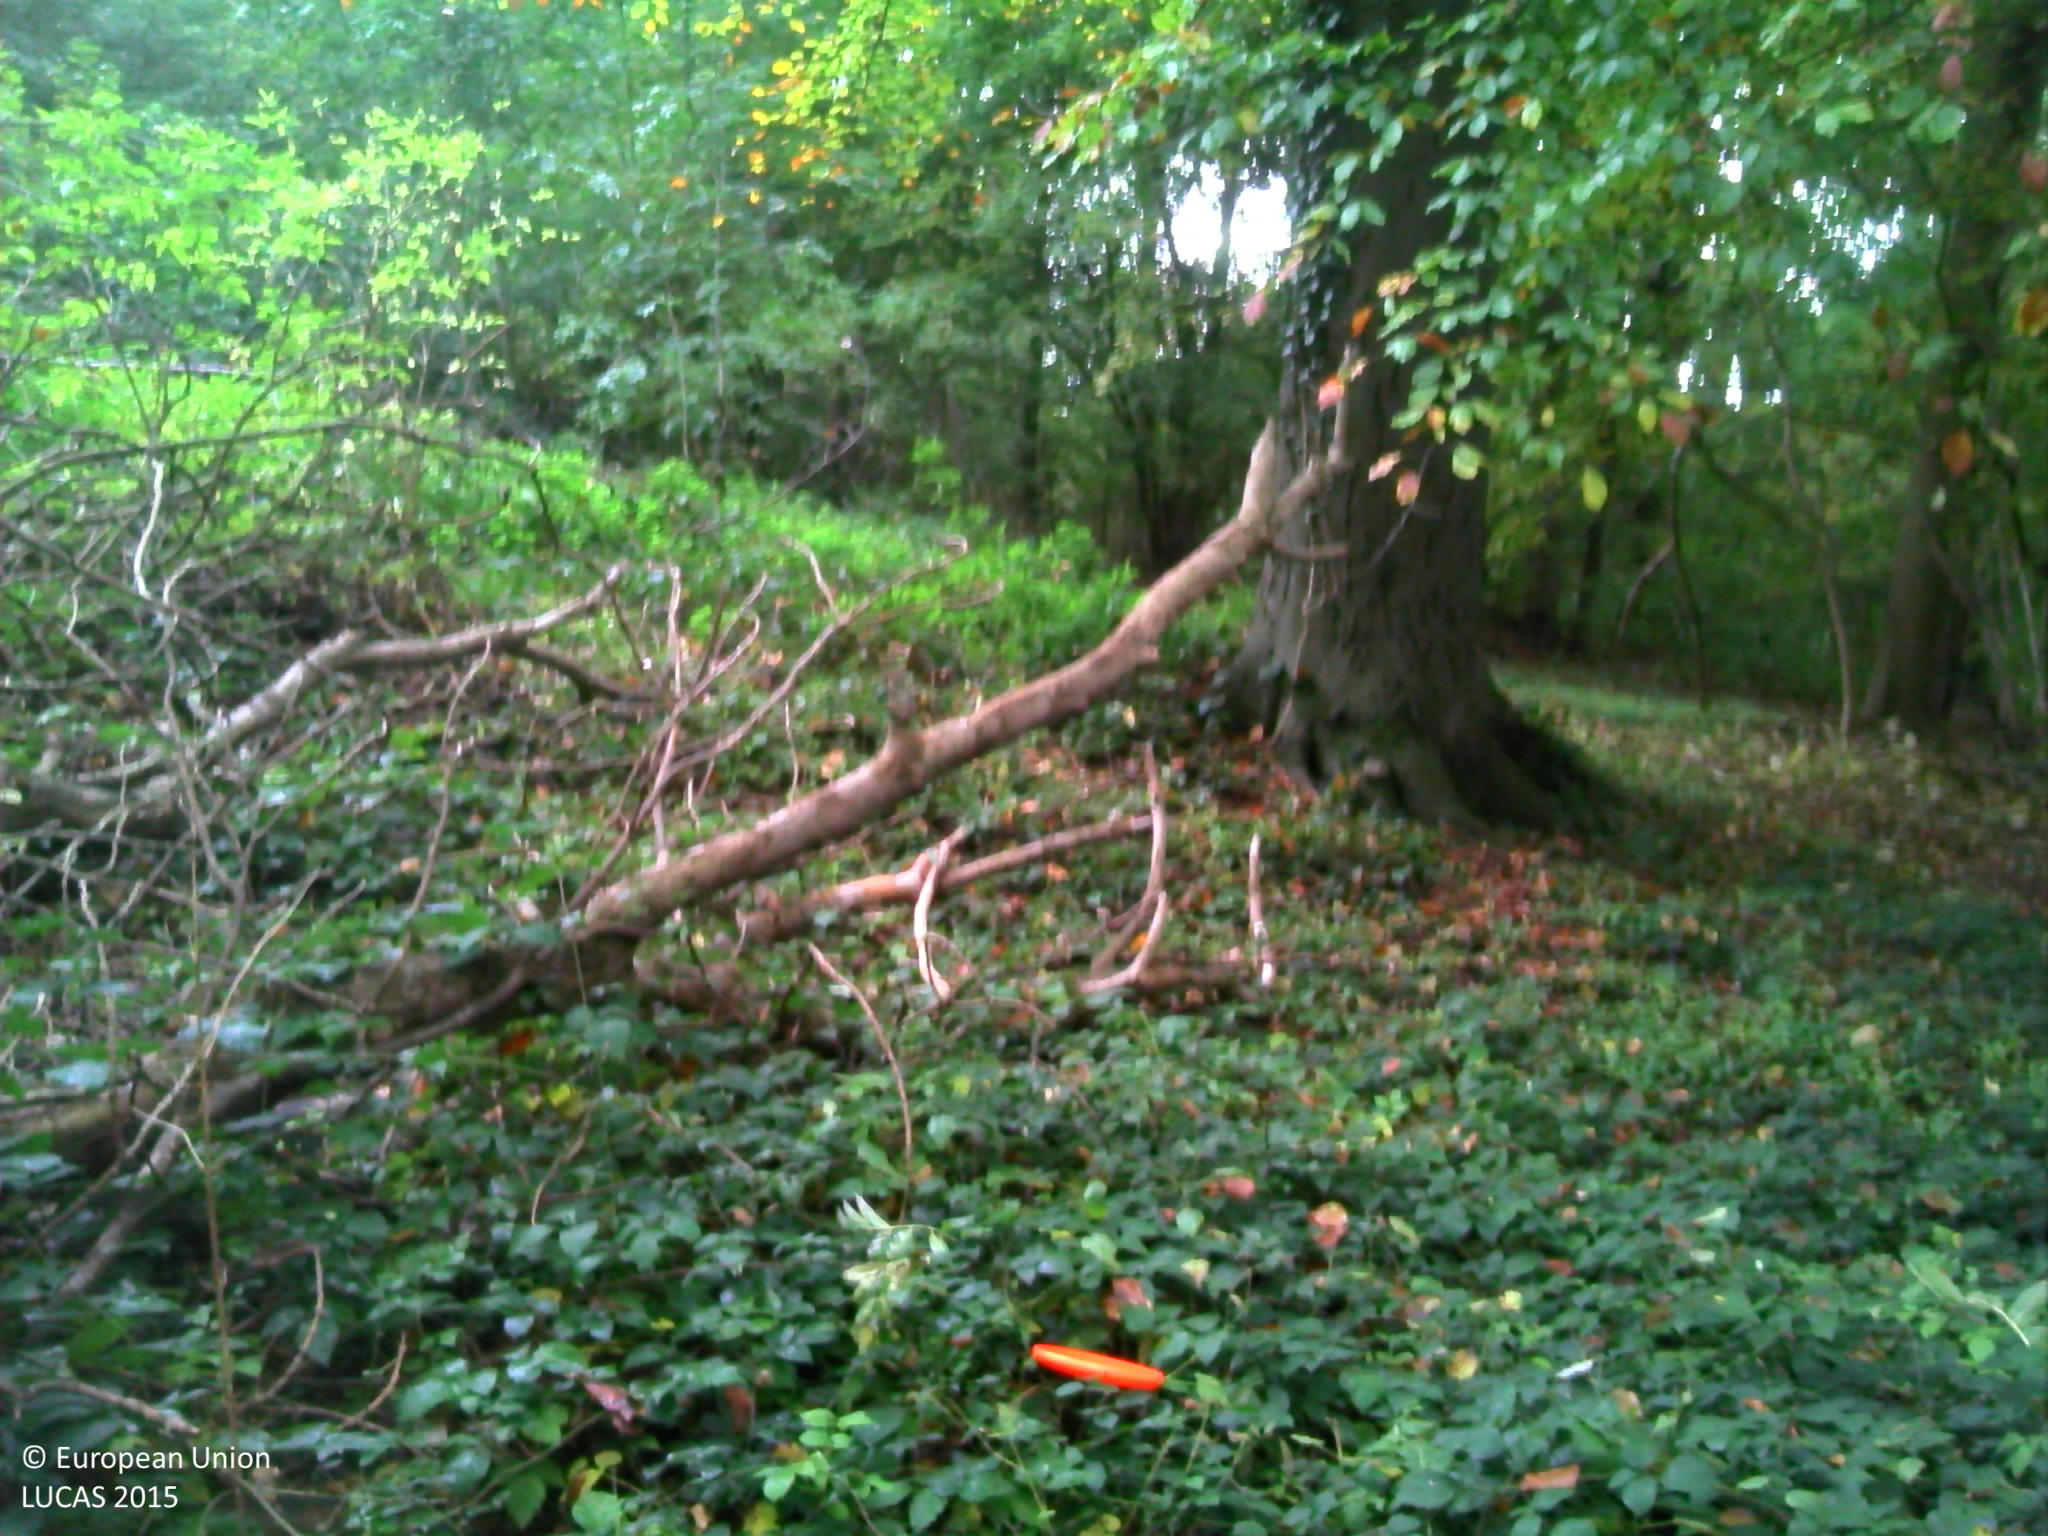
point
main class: Woodland
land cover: Broadleaved woodland
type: mesophytic deciduous forest
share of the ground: > 75 %
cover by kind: broadleaved forest trees 60 %, herbaceous plants 30 %, shrubs 10 %
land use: Forestry
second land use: Amenities, museums, leisure
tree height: > 5 m
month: October
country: BE
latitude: 50.8886
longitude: 4.2947
